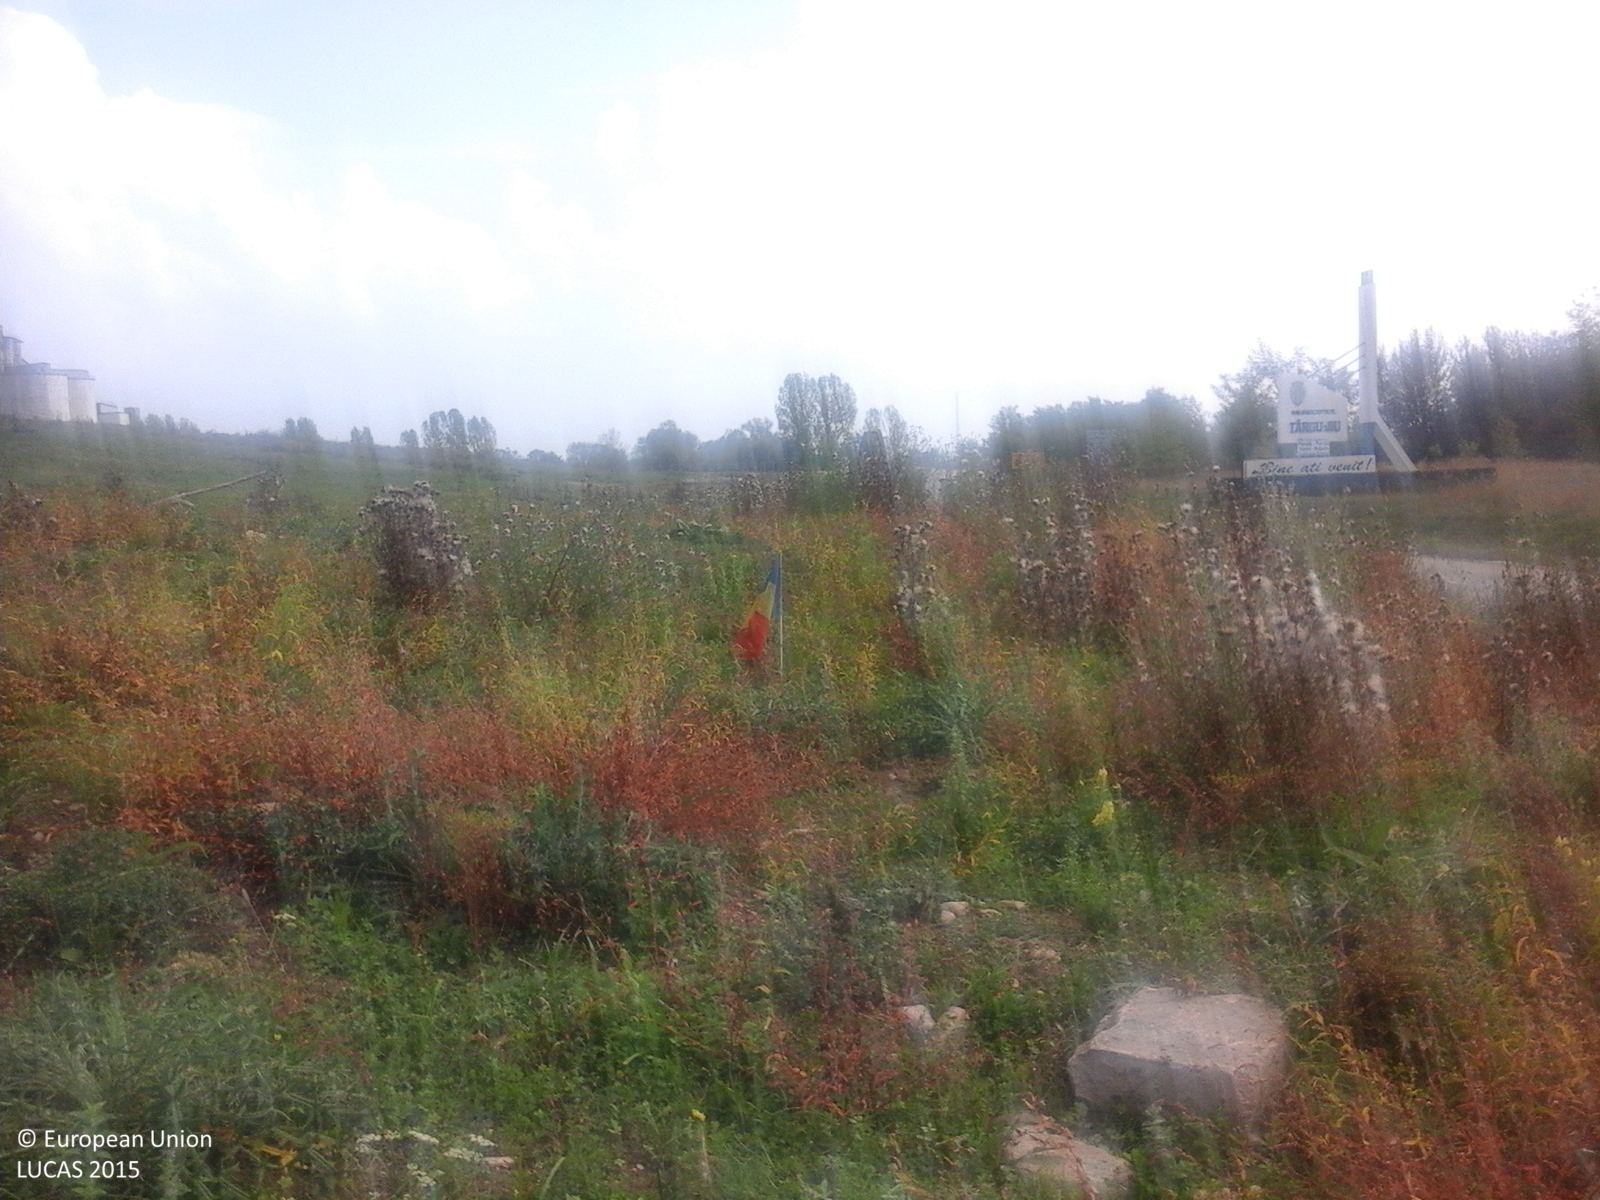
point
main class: Grassland
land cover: Spontaneously vegetated surfaces
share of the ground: > 75 %
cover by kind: herbaceous plants 100 %
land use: Fallow land
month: September
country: RO
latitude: 45.0520
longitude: 23.2203
